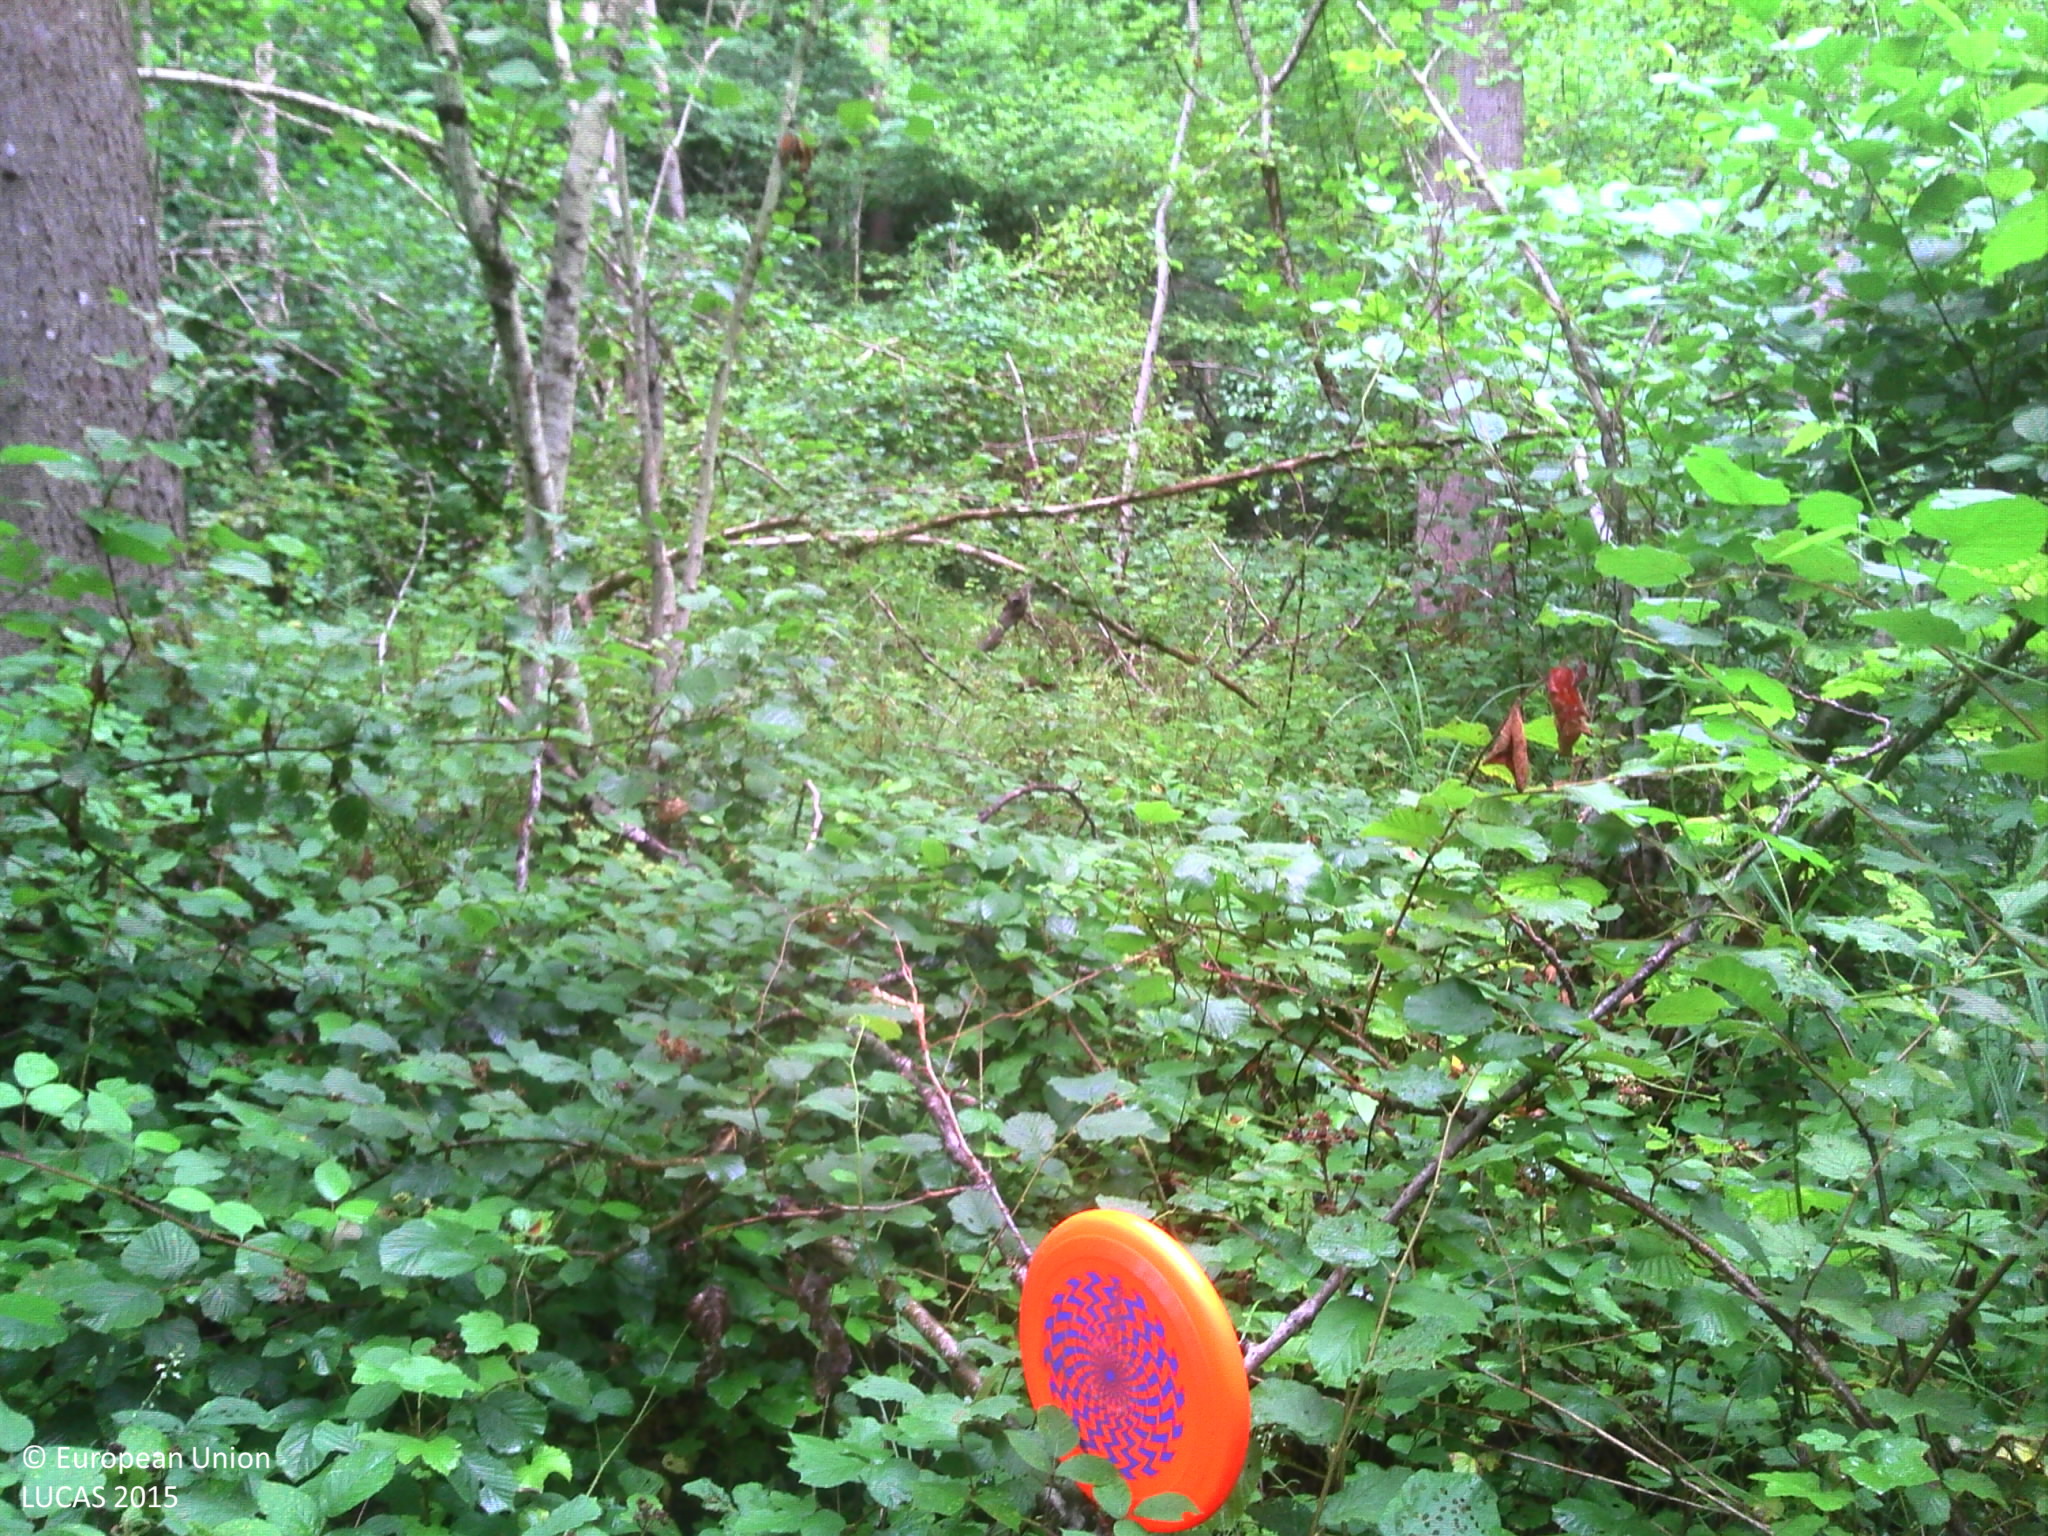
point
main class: Woodland
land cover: Broadleaved woodland
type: non-riverine alder, birch or aspen forest
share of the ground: > 75 %
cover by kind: broadleaved forest trees 75 %, herbaceous plants 20 %, shrubs 5 %
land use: Forestry
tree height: > 5 m
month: July
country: FR
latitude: 46.7223
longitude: 5.0168
